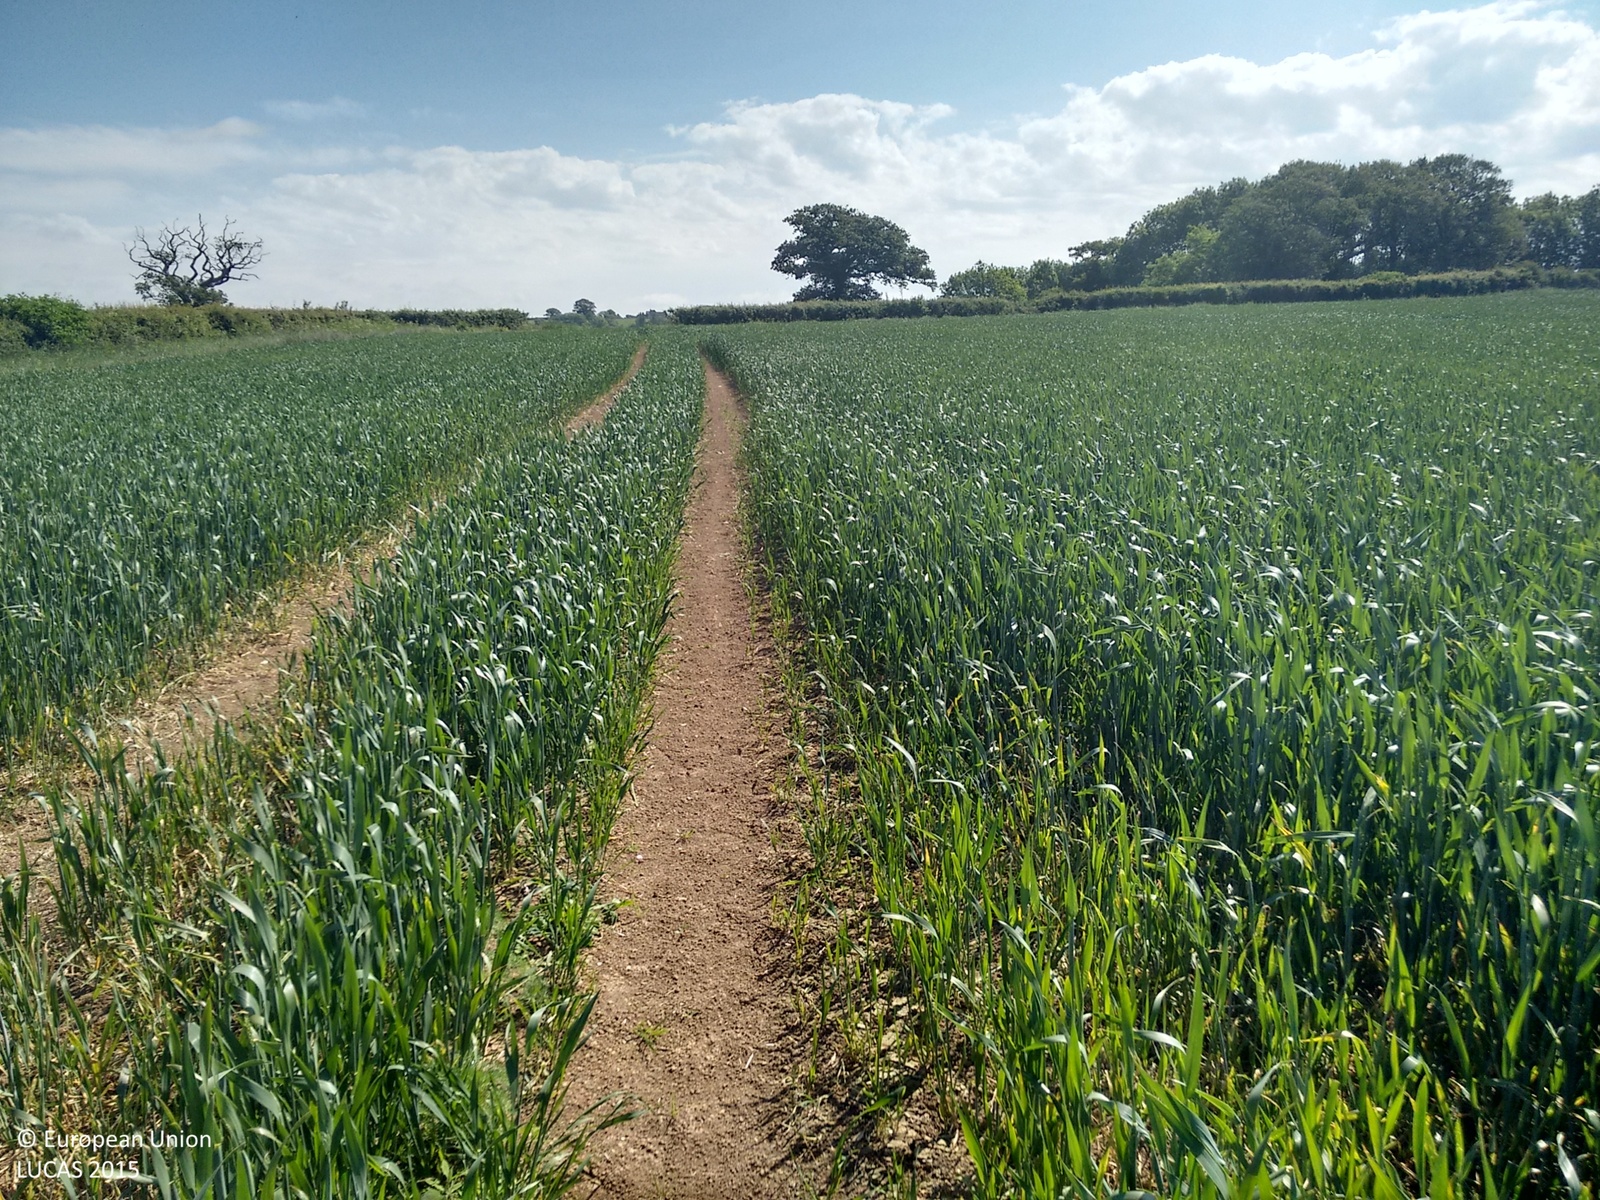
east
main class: Cropland
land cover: Common wheat
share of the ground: > 75 %
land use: Agriculture (excluding fallow land and kitchen gardens)
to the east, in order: Common wheat; Grass margins; Ditches and canals; Grass margins; Managed hedges; Spontaneously vegetated surfaces; Common wheat; Spontaneously vegetated surfaces; Broadleaved woodland; Artificial constructions in urban areas; Broadleaved woodland; Grassland without tree/shrub cover
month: June
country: GB
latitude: 50.8706
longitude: -2.3845
